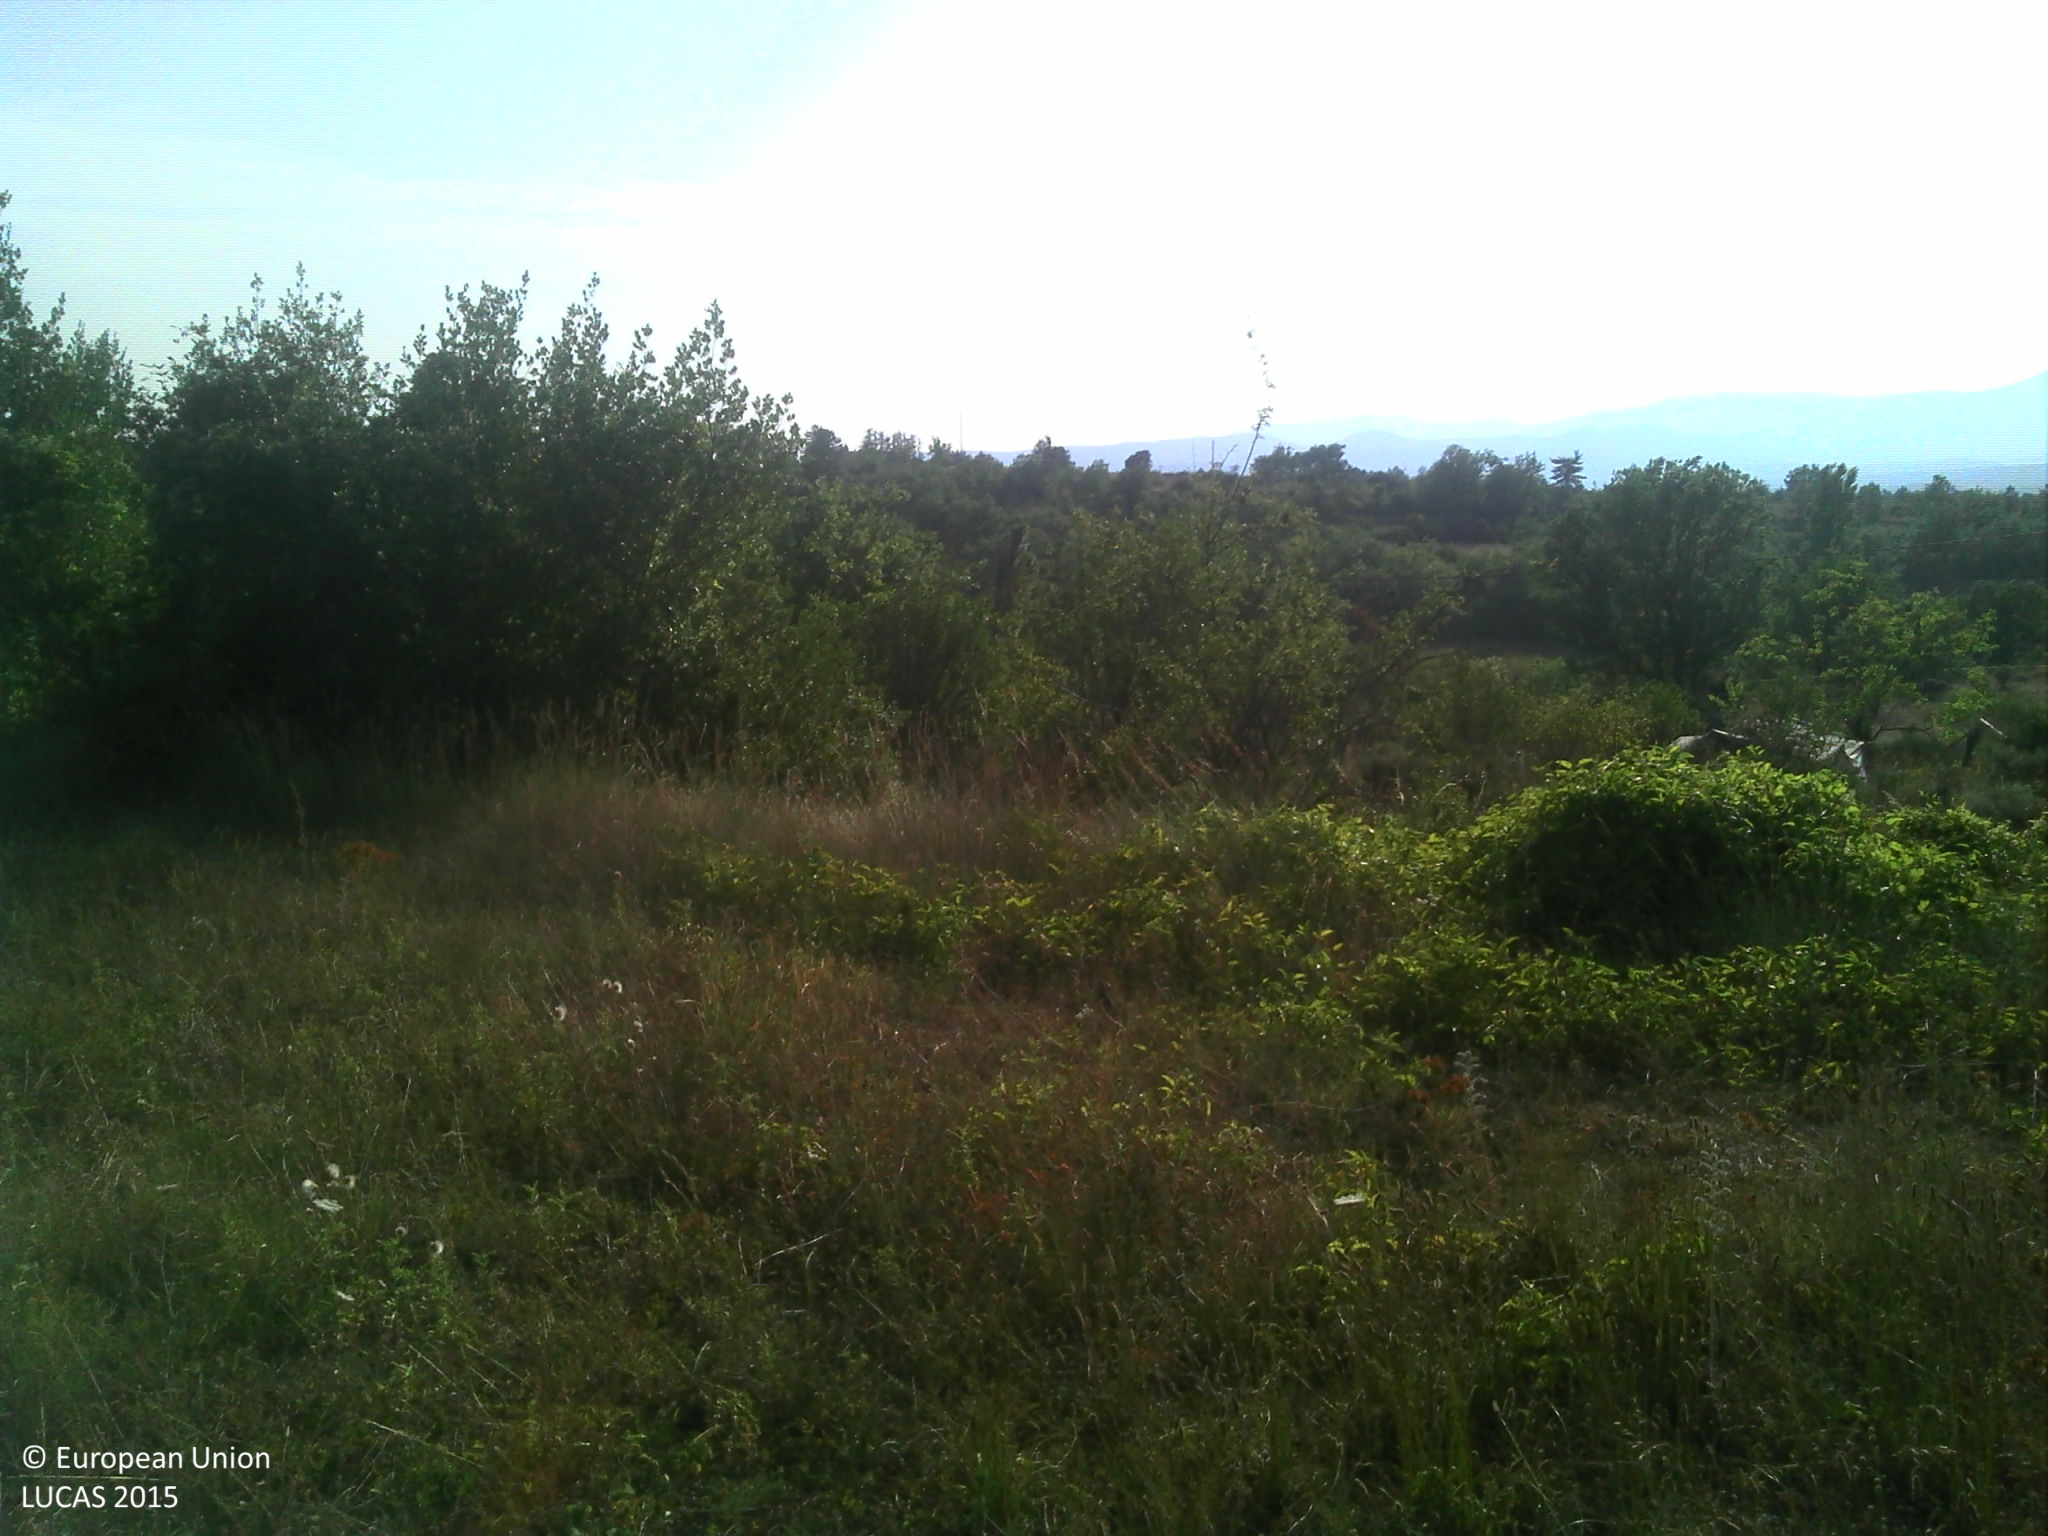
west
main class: Grassland
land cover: Grassland without tree/shrub cover
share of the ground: > 75 %
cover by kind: herbaceous plants 100 %
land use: Semi-natural and natural areas not in use
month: July
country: FR
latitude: 44.3731
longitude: 4.2716
